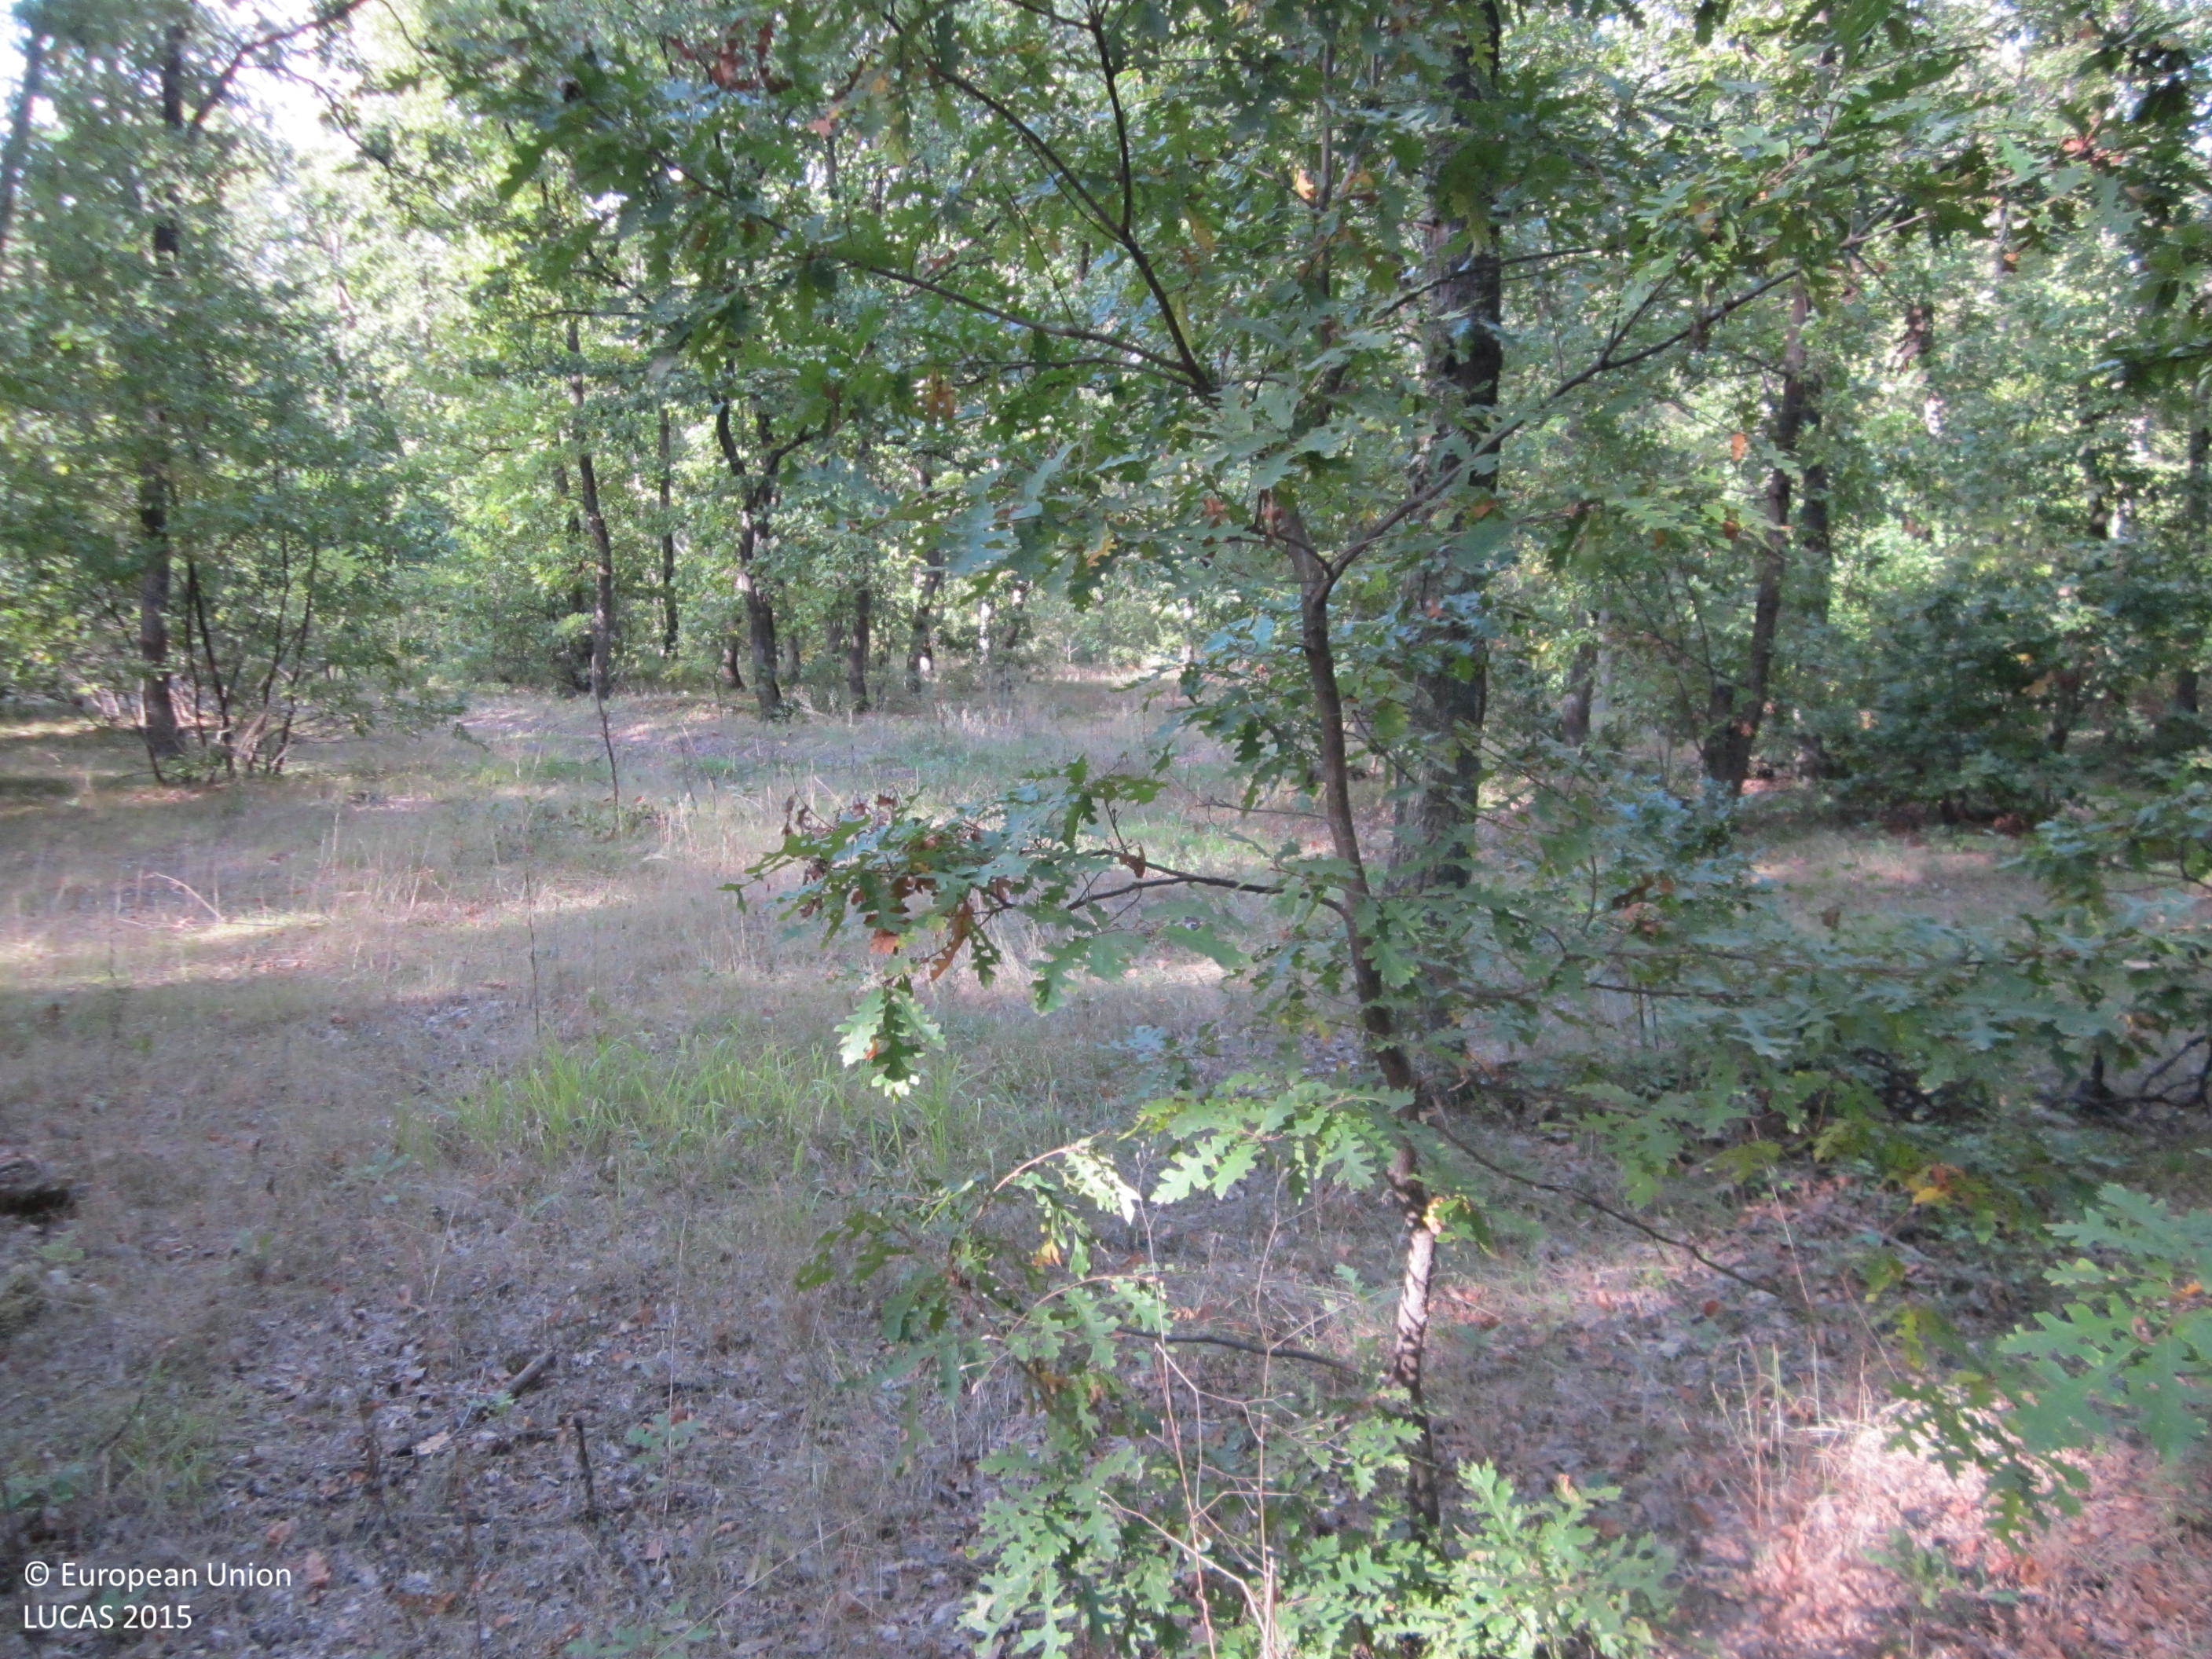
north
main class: Woodland
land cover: Broadleaved woodland
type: acidophilous oak and oak-birch forest
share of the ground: 50 - 75 %
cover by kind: broadleaved forest trees 65 %, herbaceous plants 35 %
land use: Forestry
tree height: > 5 m
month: October
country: BG
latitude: 42.8097
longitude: 26.8715
